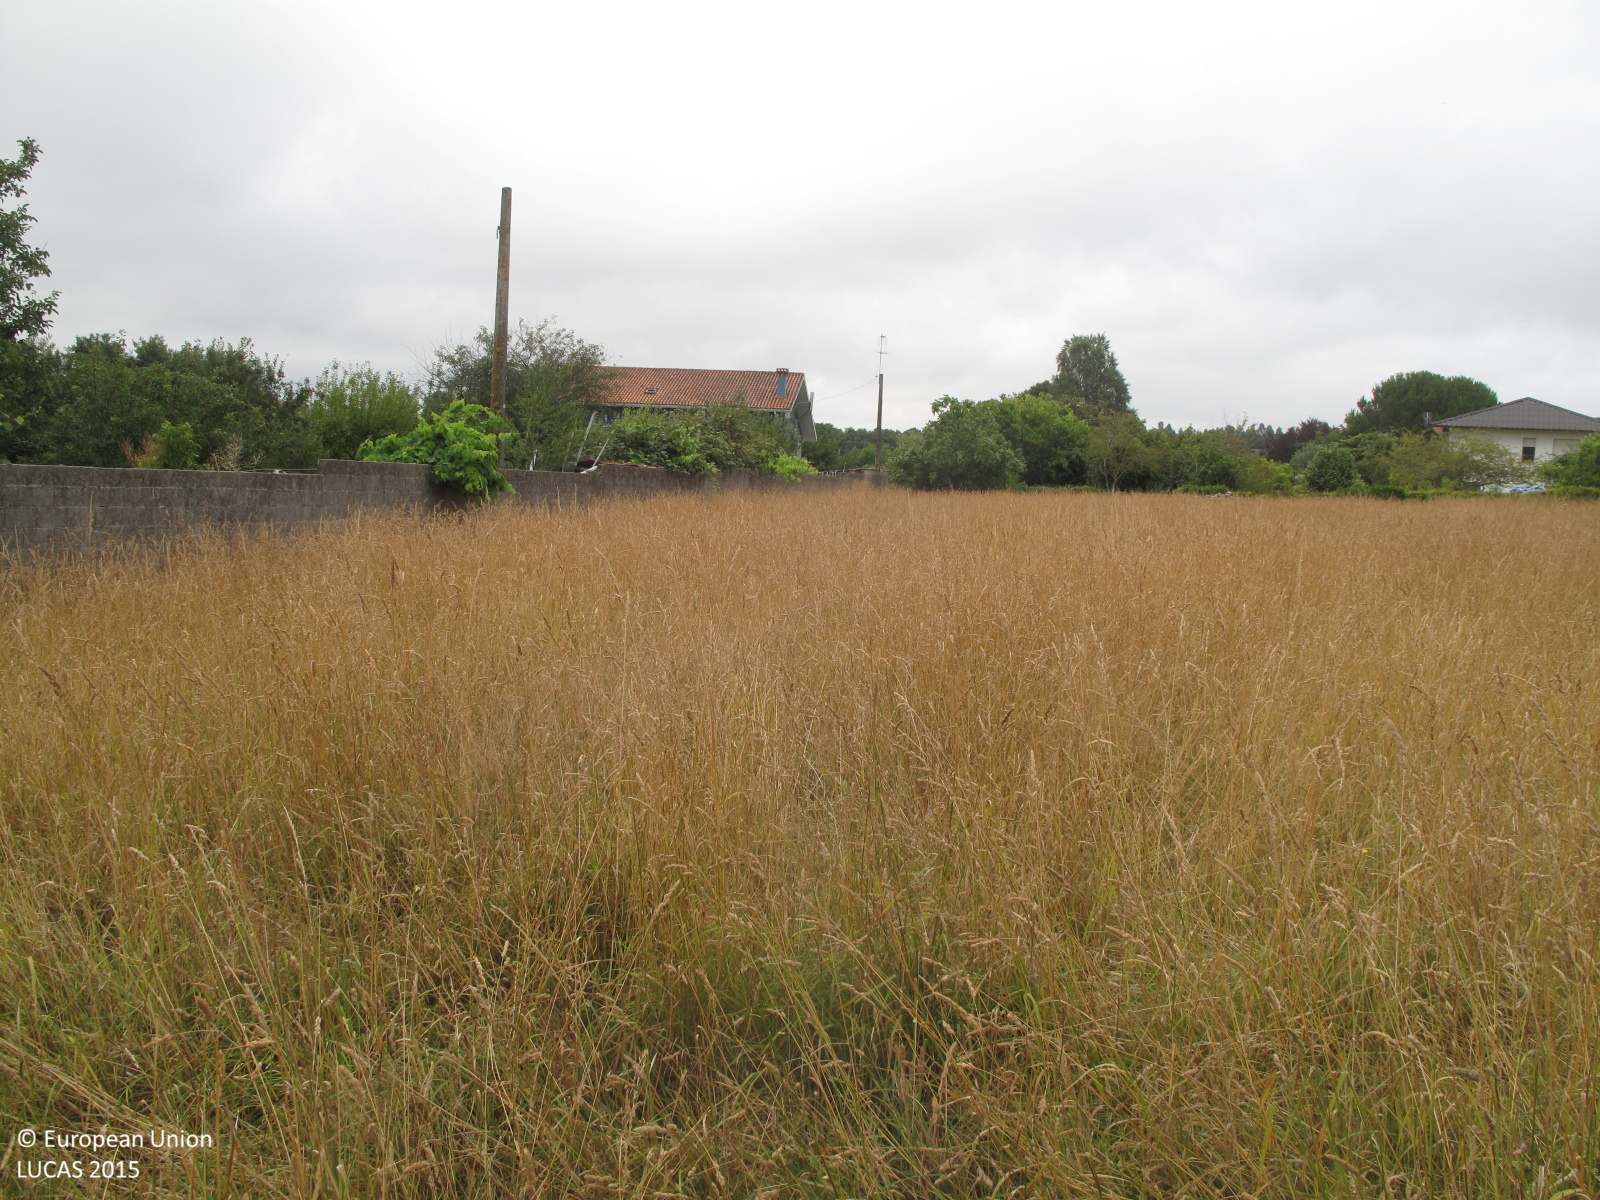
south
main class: Grassland
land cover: Grassland without tree/shrub cover
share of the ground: > 75 %
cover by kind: herbaceous plants 100 %
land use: Agriculture (excluding fallow land and kitchen gardens)
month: July
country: ES
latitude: 43.5394
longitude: -8.1828
